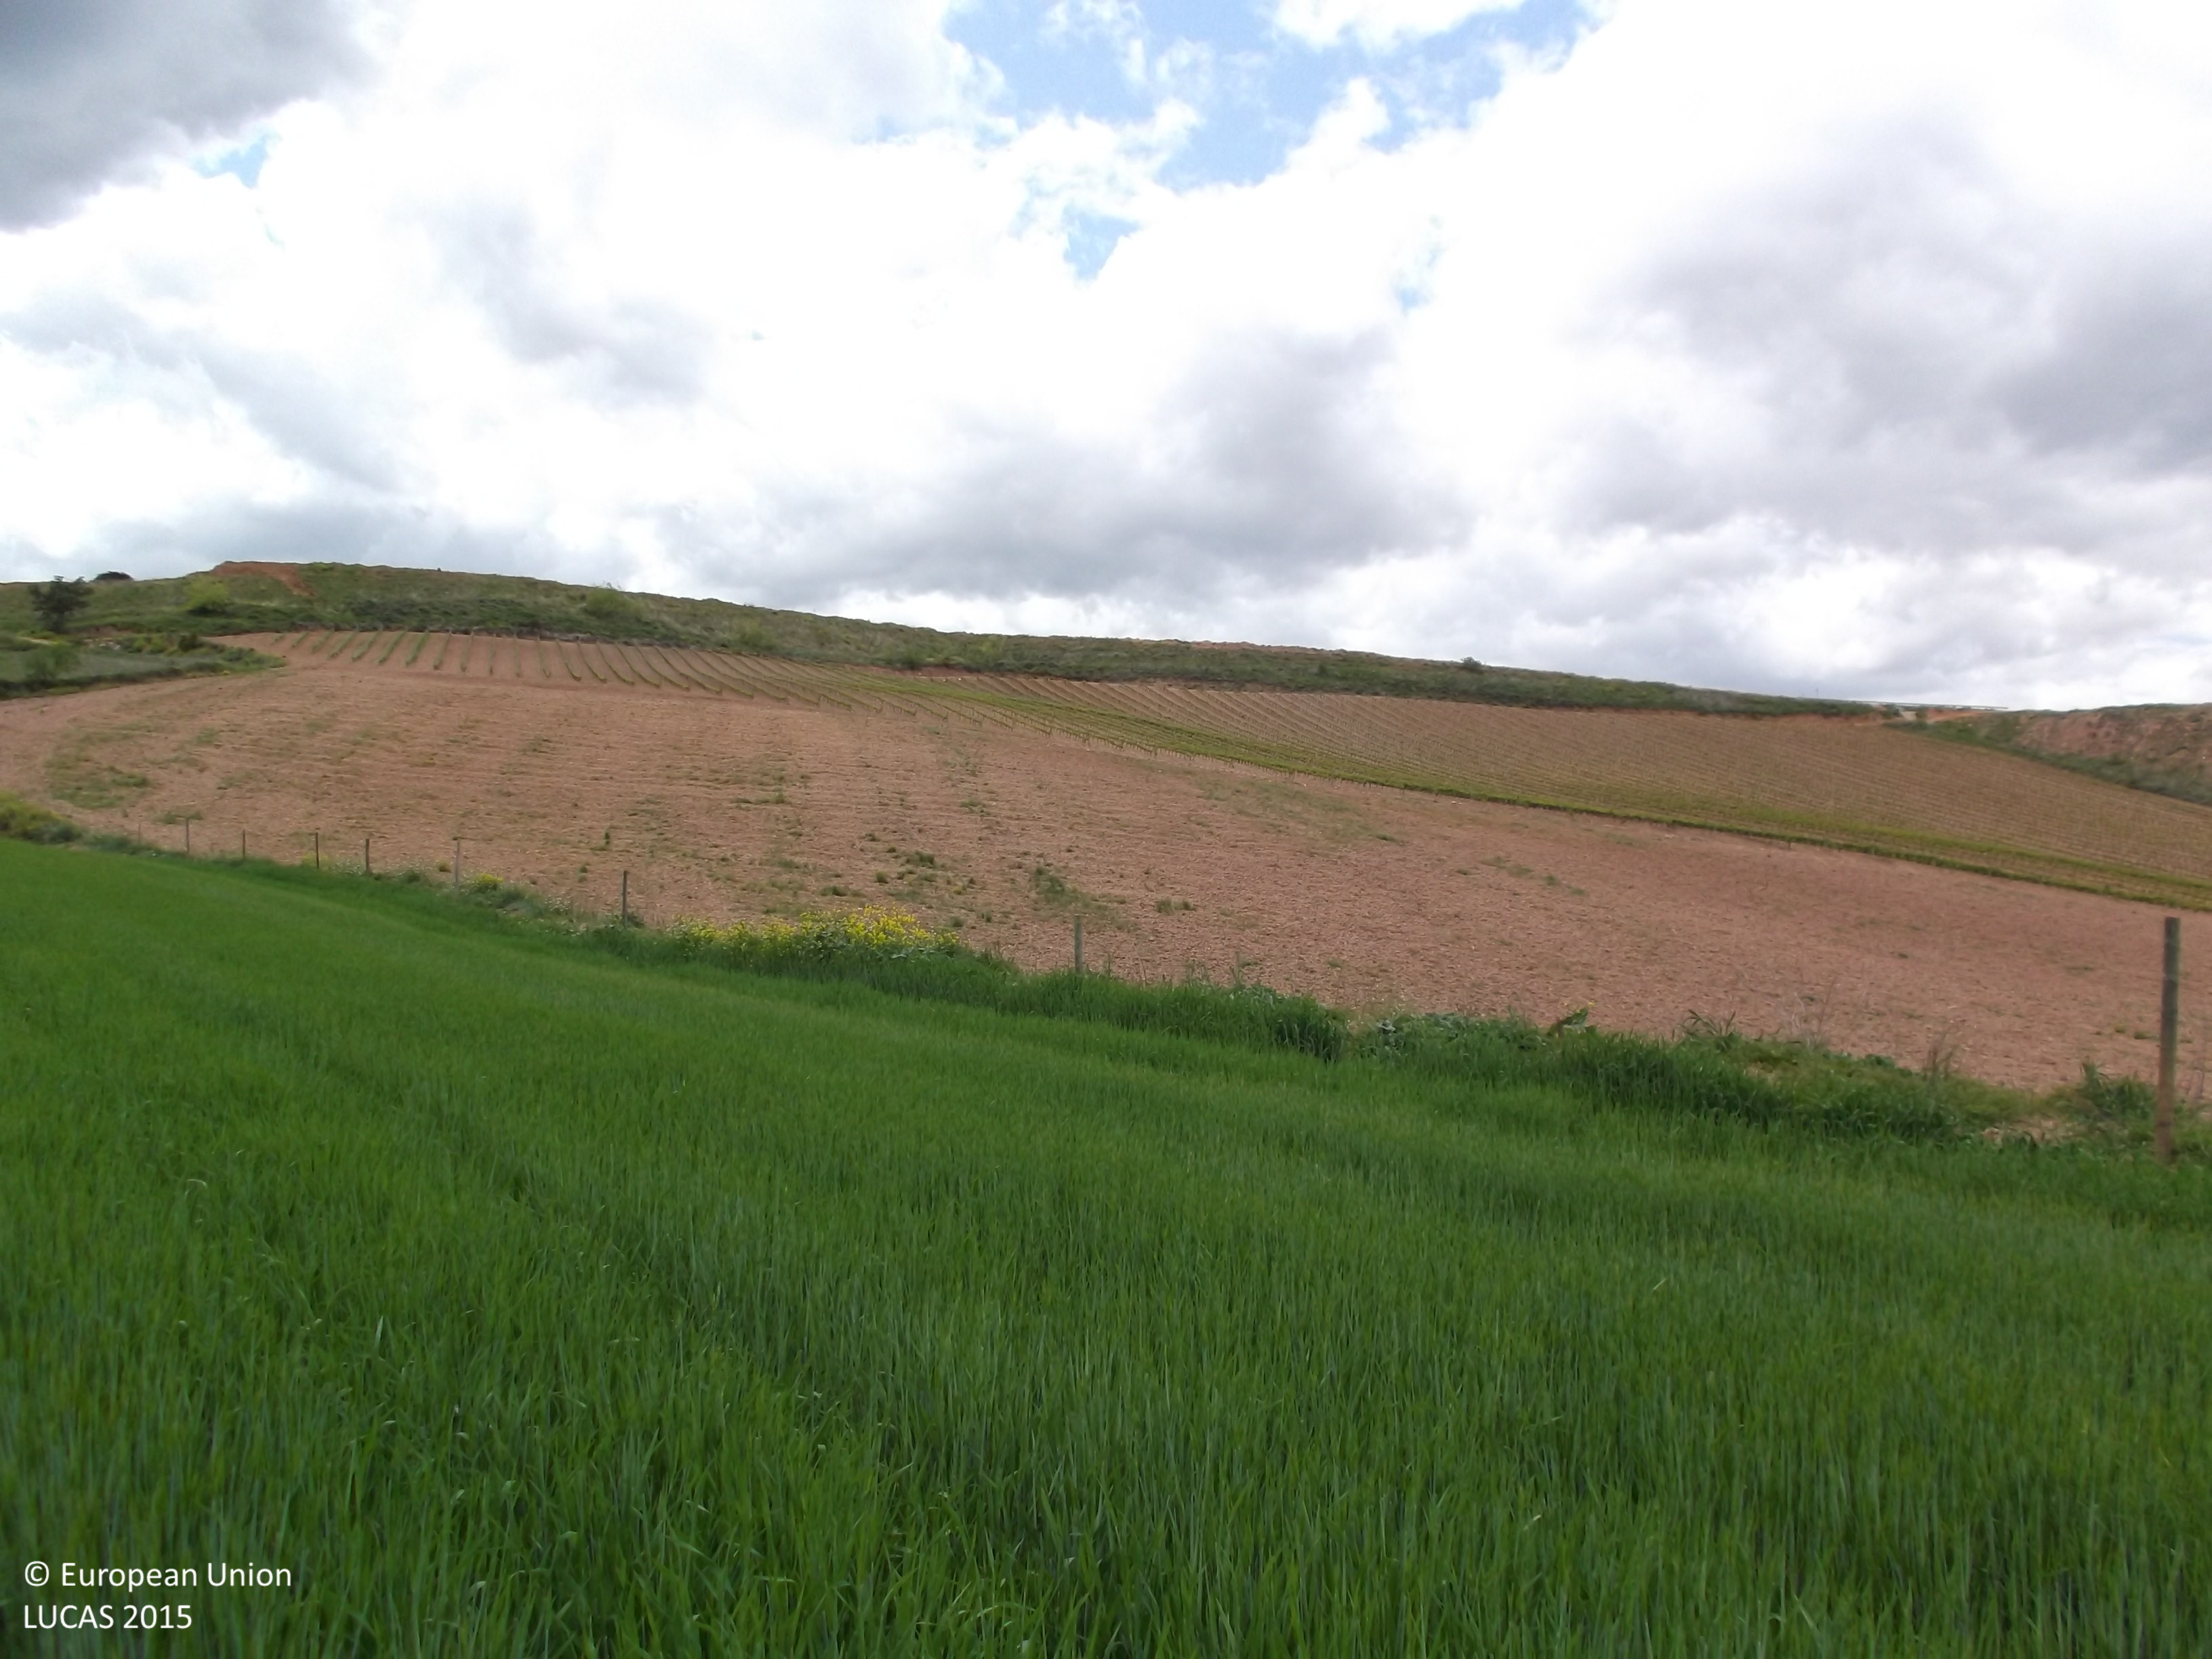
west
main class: Cropland
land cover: Barley
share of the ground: > 75 %
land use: Agriculture (excluding fallow land and kitchen gardens)
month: May
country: ES
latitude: 42.3792
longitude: -2.4196
